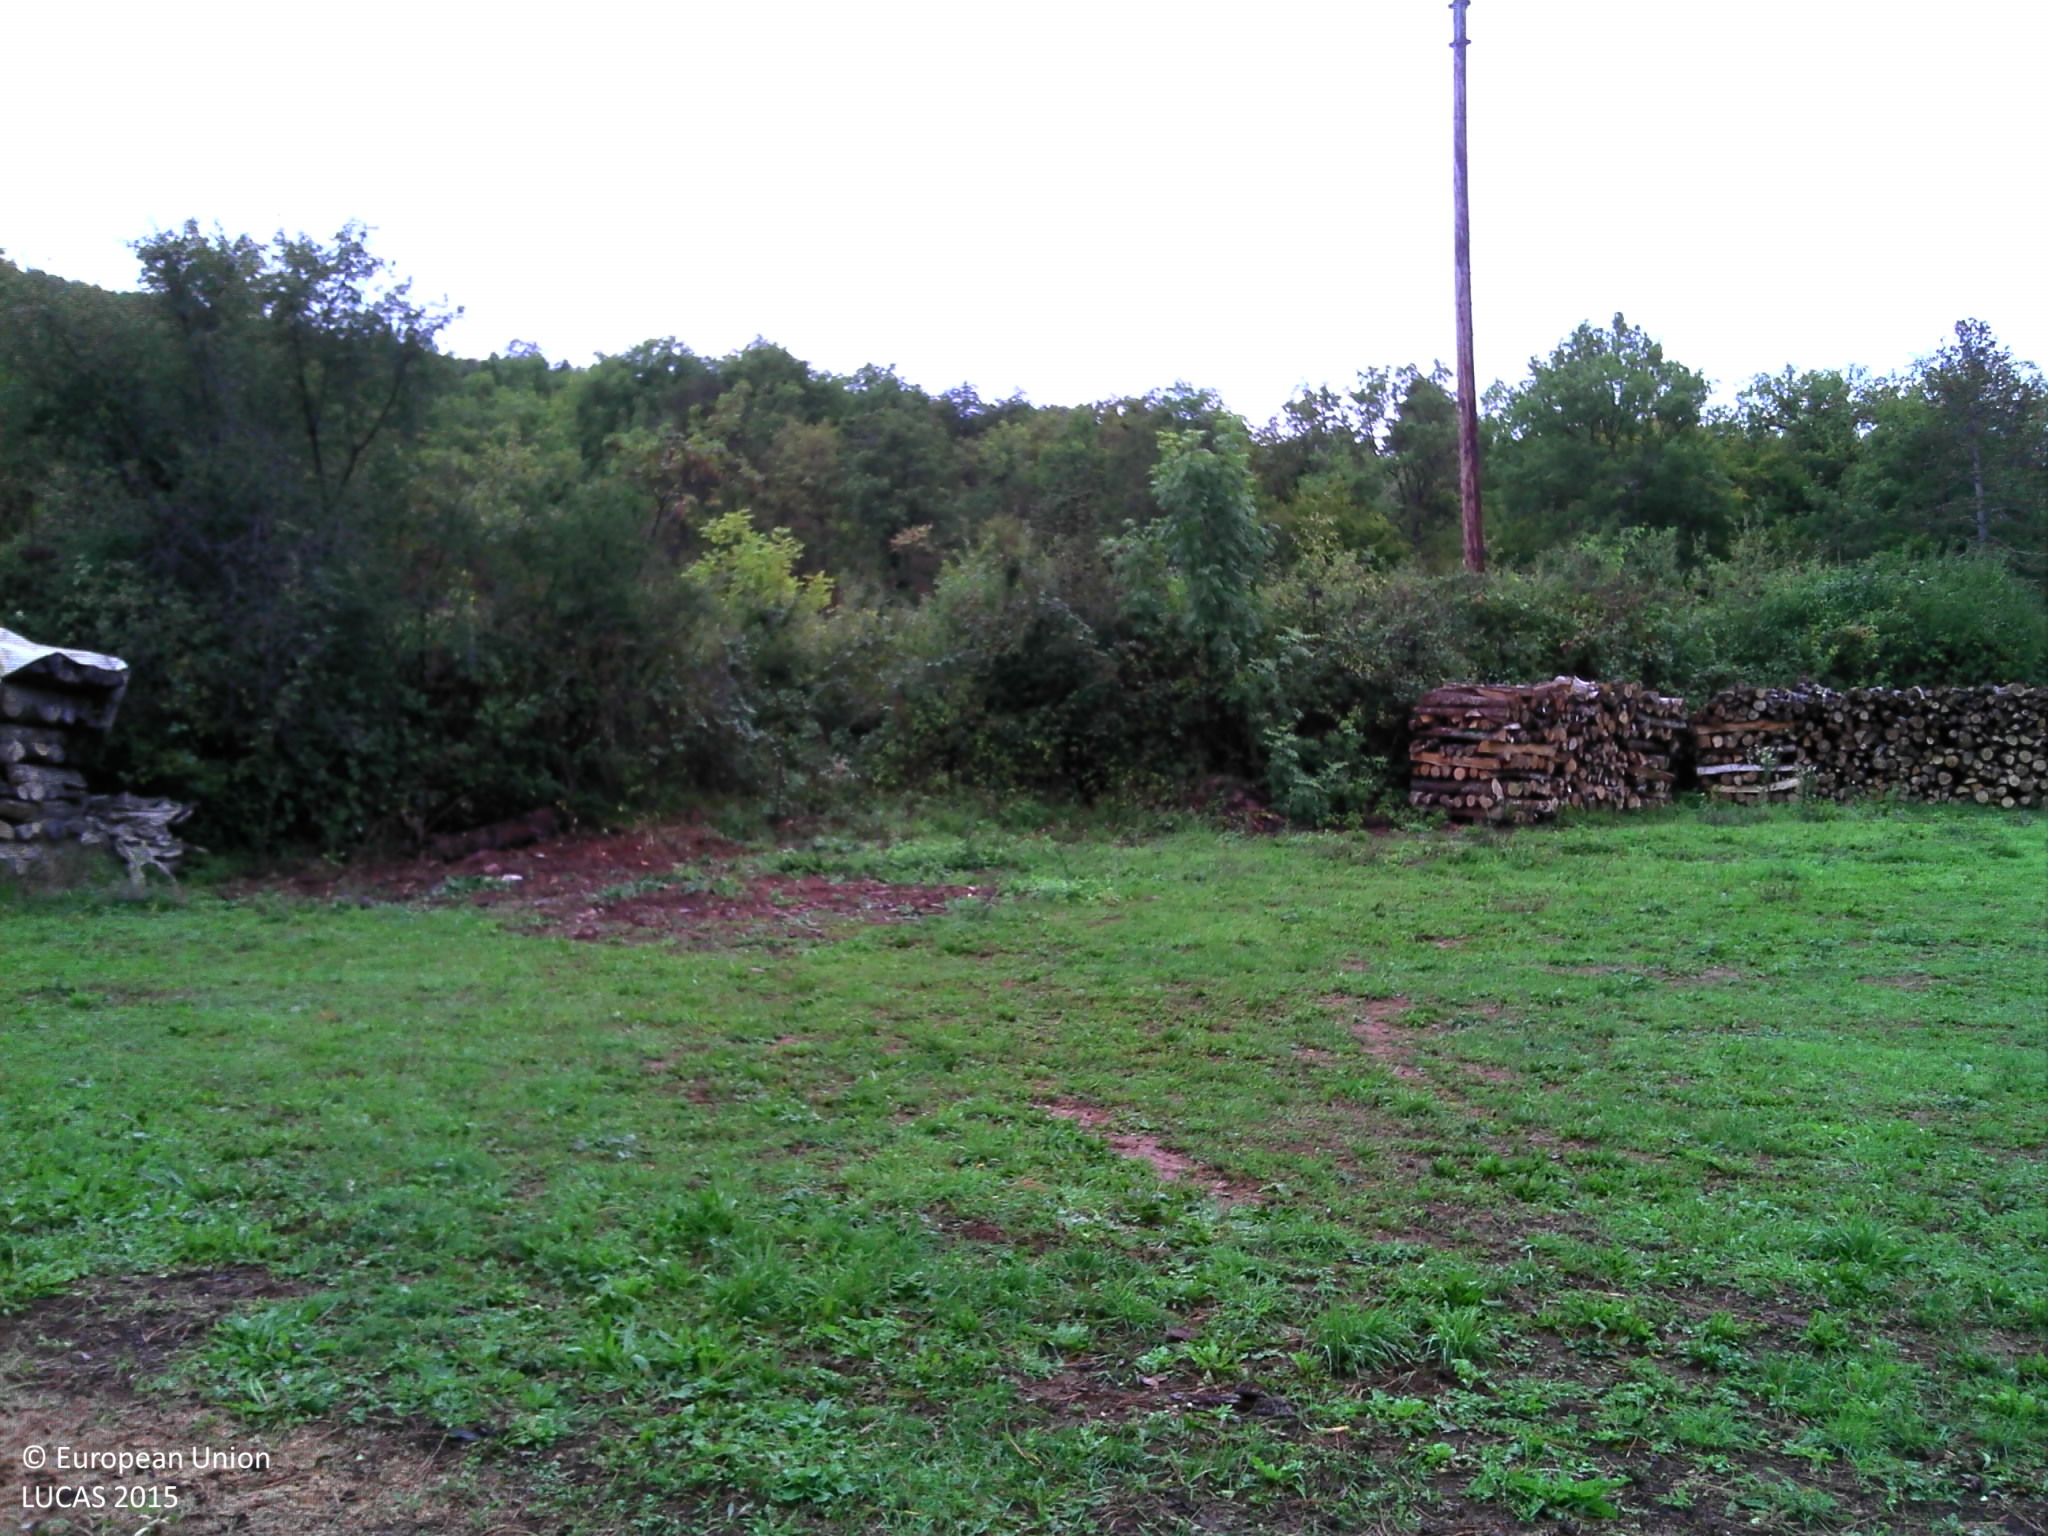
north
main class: Grassland
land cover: Grassland without tree/shrub cover
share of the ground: > 75 %
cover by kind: herbaceous plants 100 %
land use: Agriculture (excluding fallow land and kitchen gardens)
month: September
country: FR
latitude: 47.0728
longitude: 4.7988
